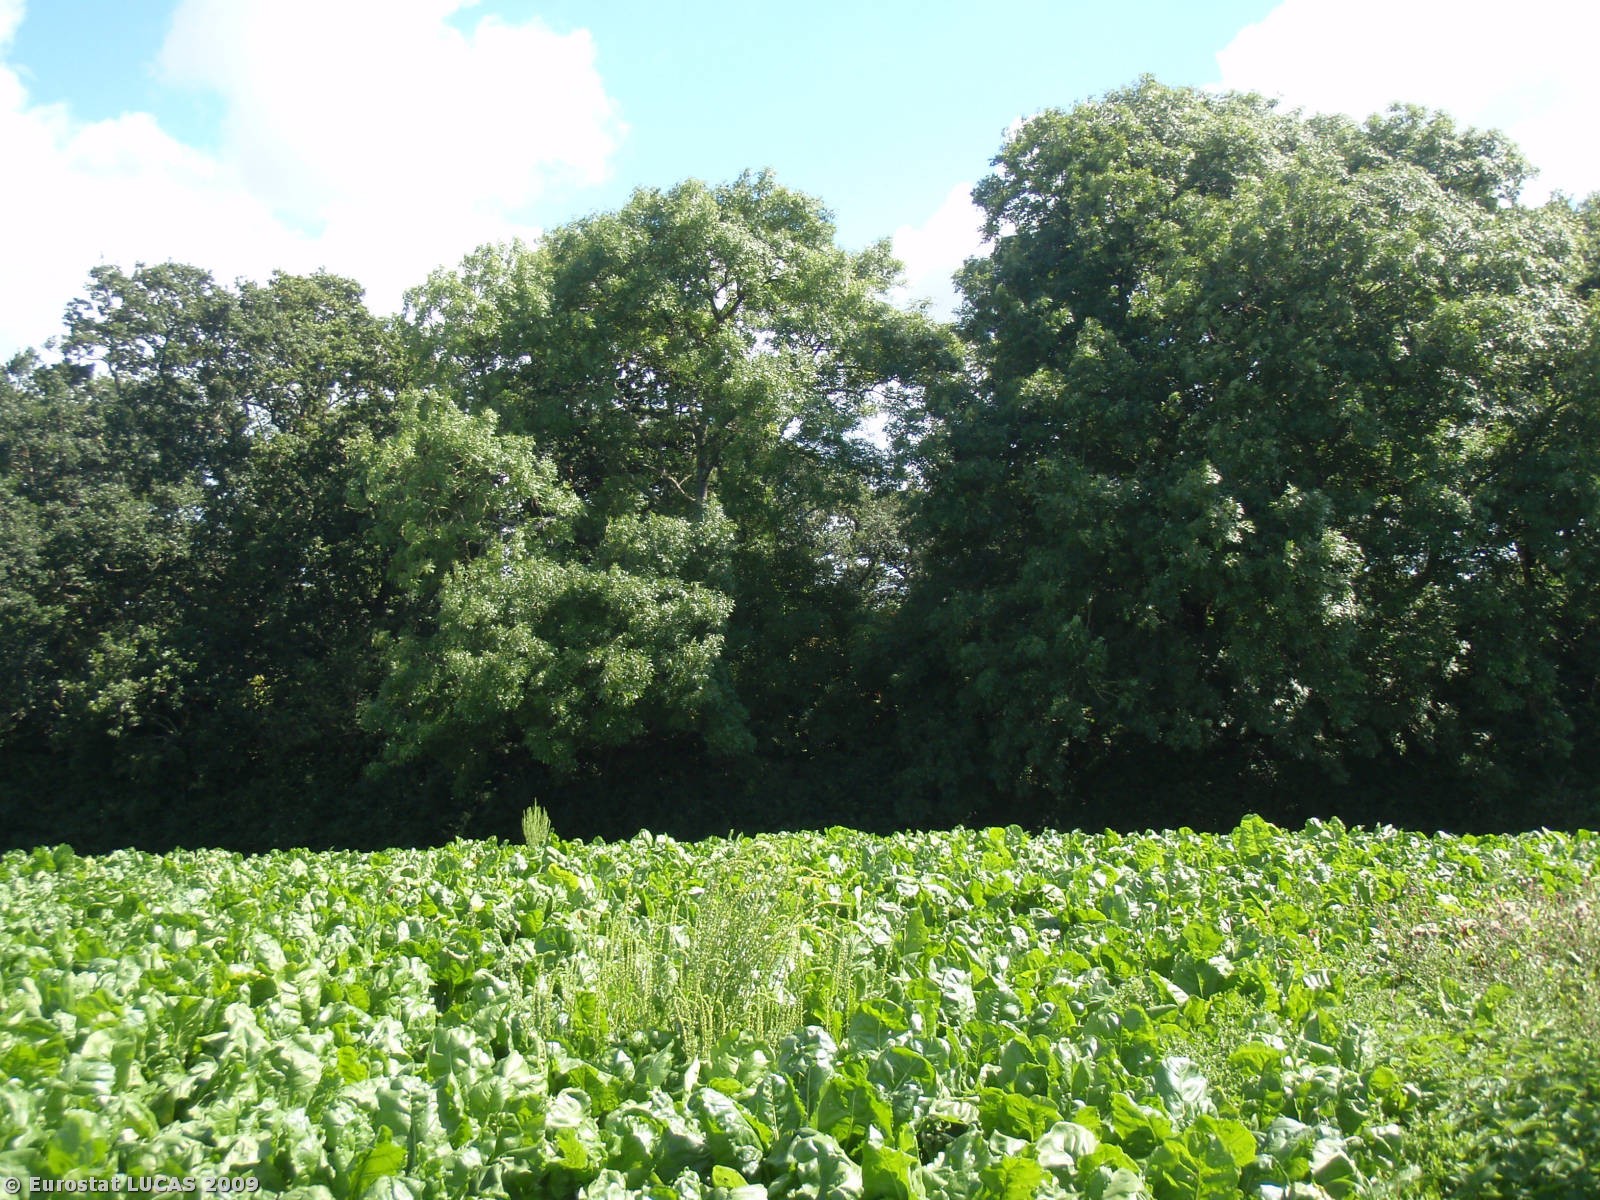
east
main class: Woodland
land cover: Broadleaved woodland
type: mesophytic deciduous forest
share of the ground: > 75 %
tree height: > 5 m
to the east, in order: Broadleaved woodland; Other root crops; Artificial constructions; Broadleaved woodland
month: August
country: GB
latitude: 50.6769
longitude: -4.3518
